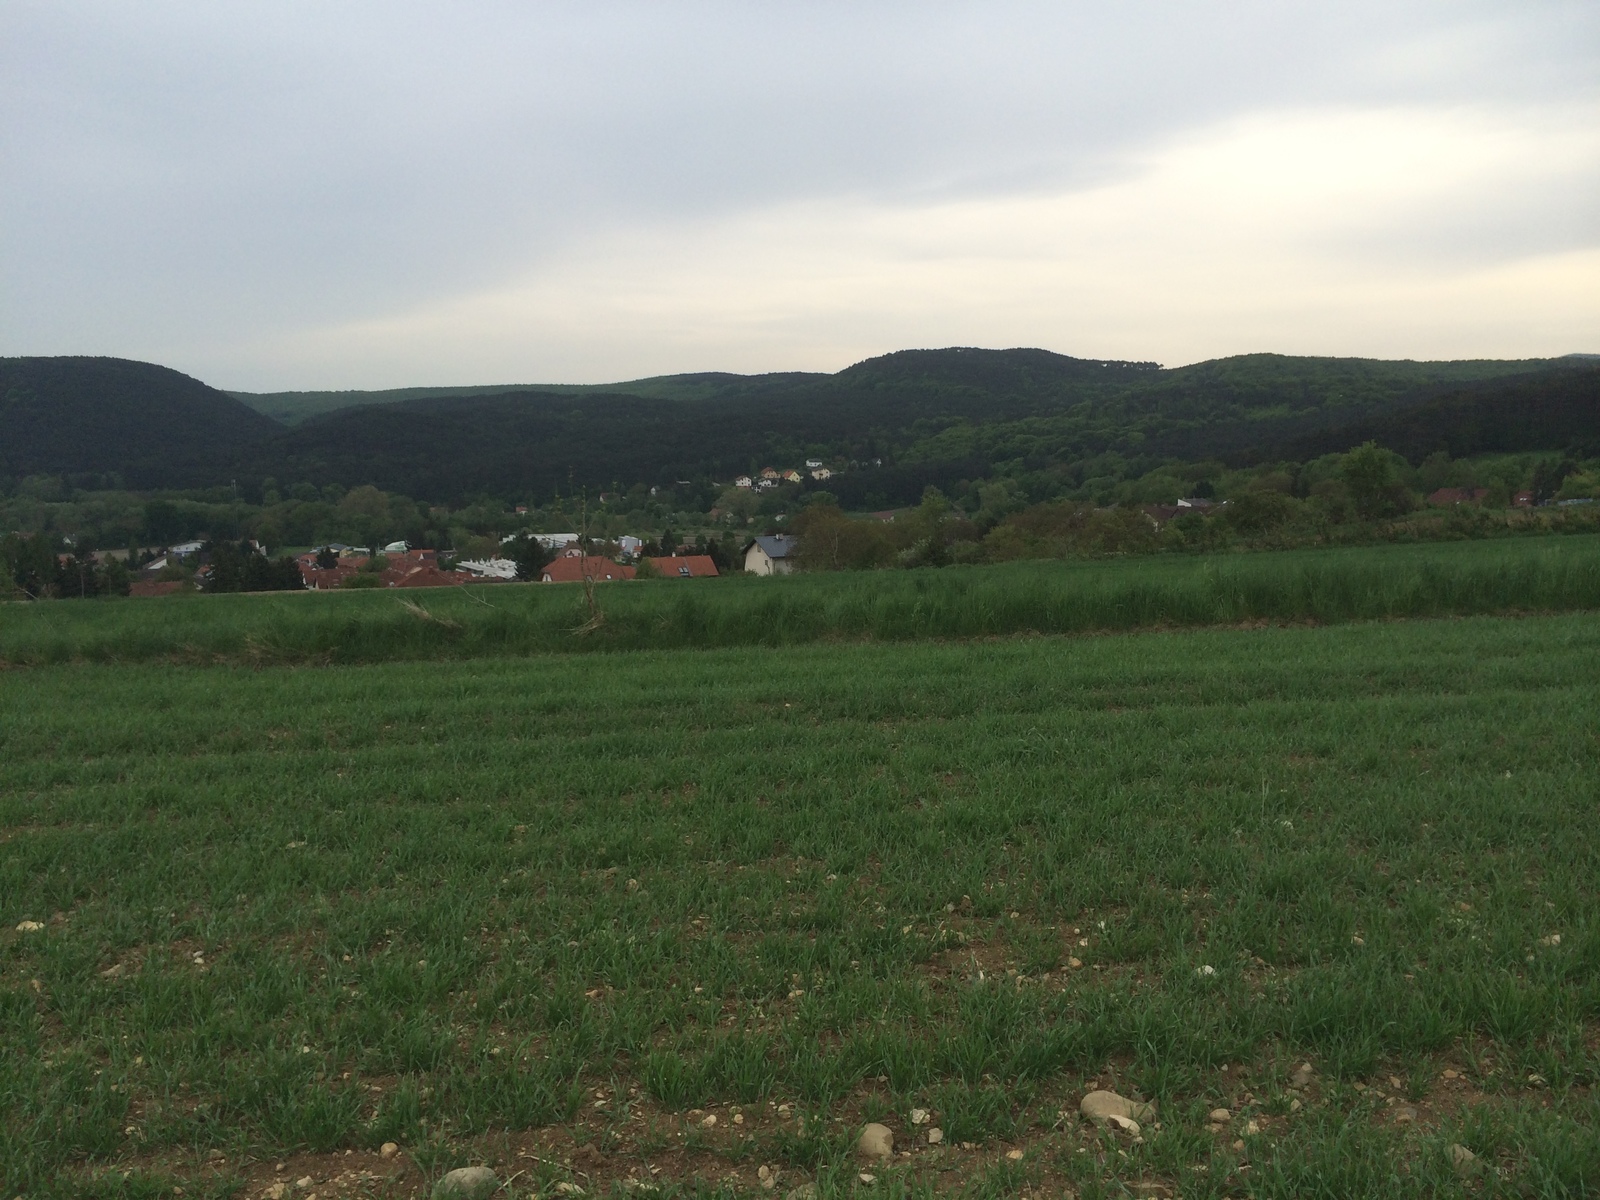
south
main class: Cropland
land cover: Barley
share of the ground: > 75 %
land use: Agriculture (excluding fallow land and kitchen gardens)
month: May
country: AT
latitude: 47.9436
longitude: 16.1488
